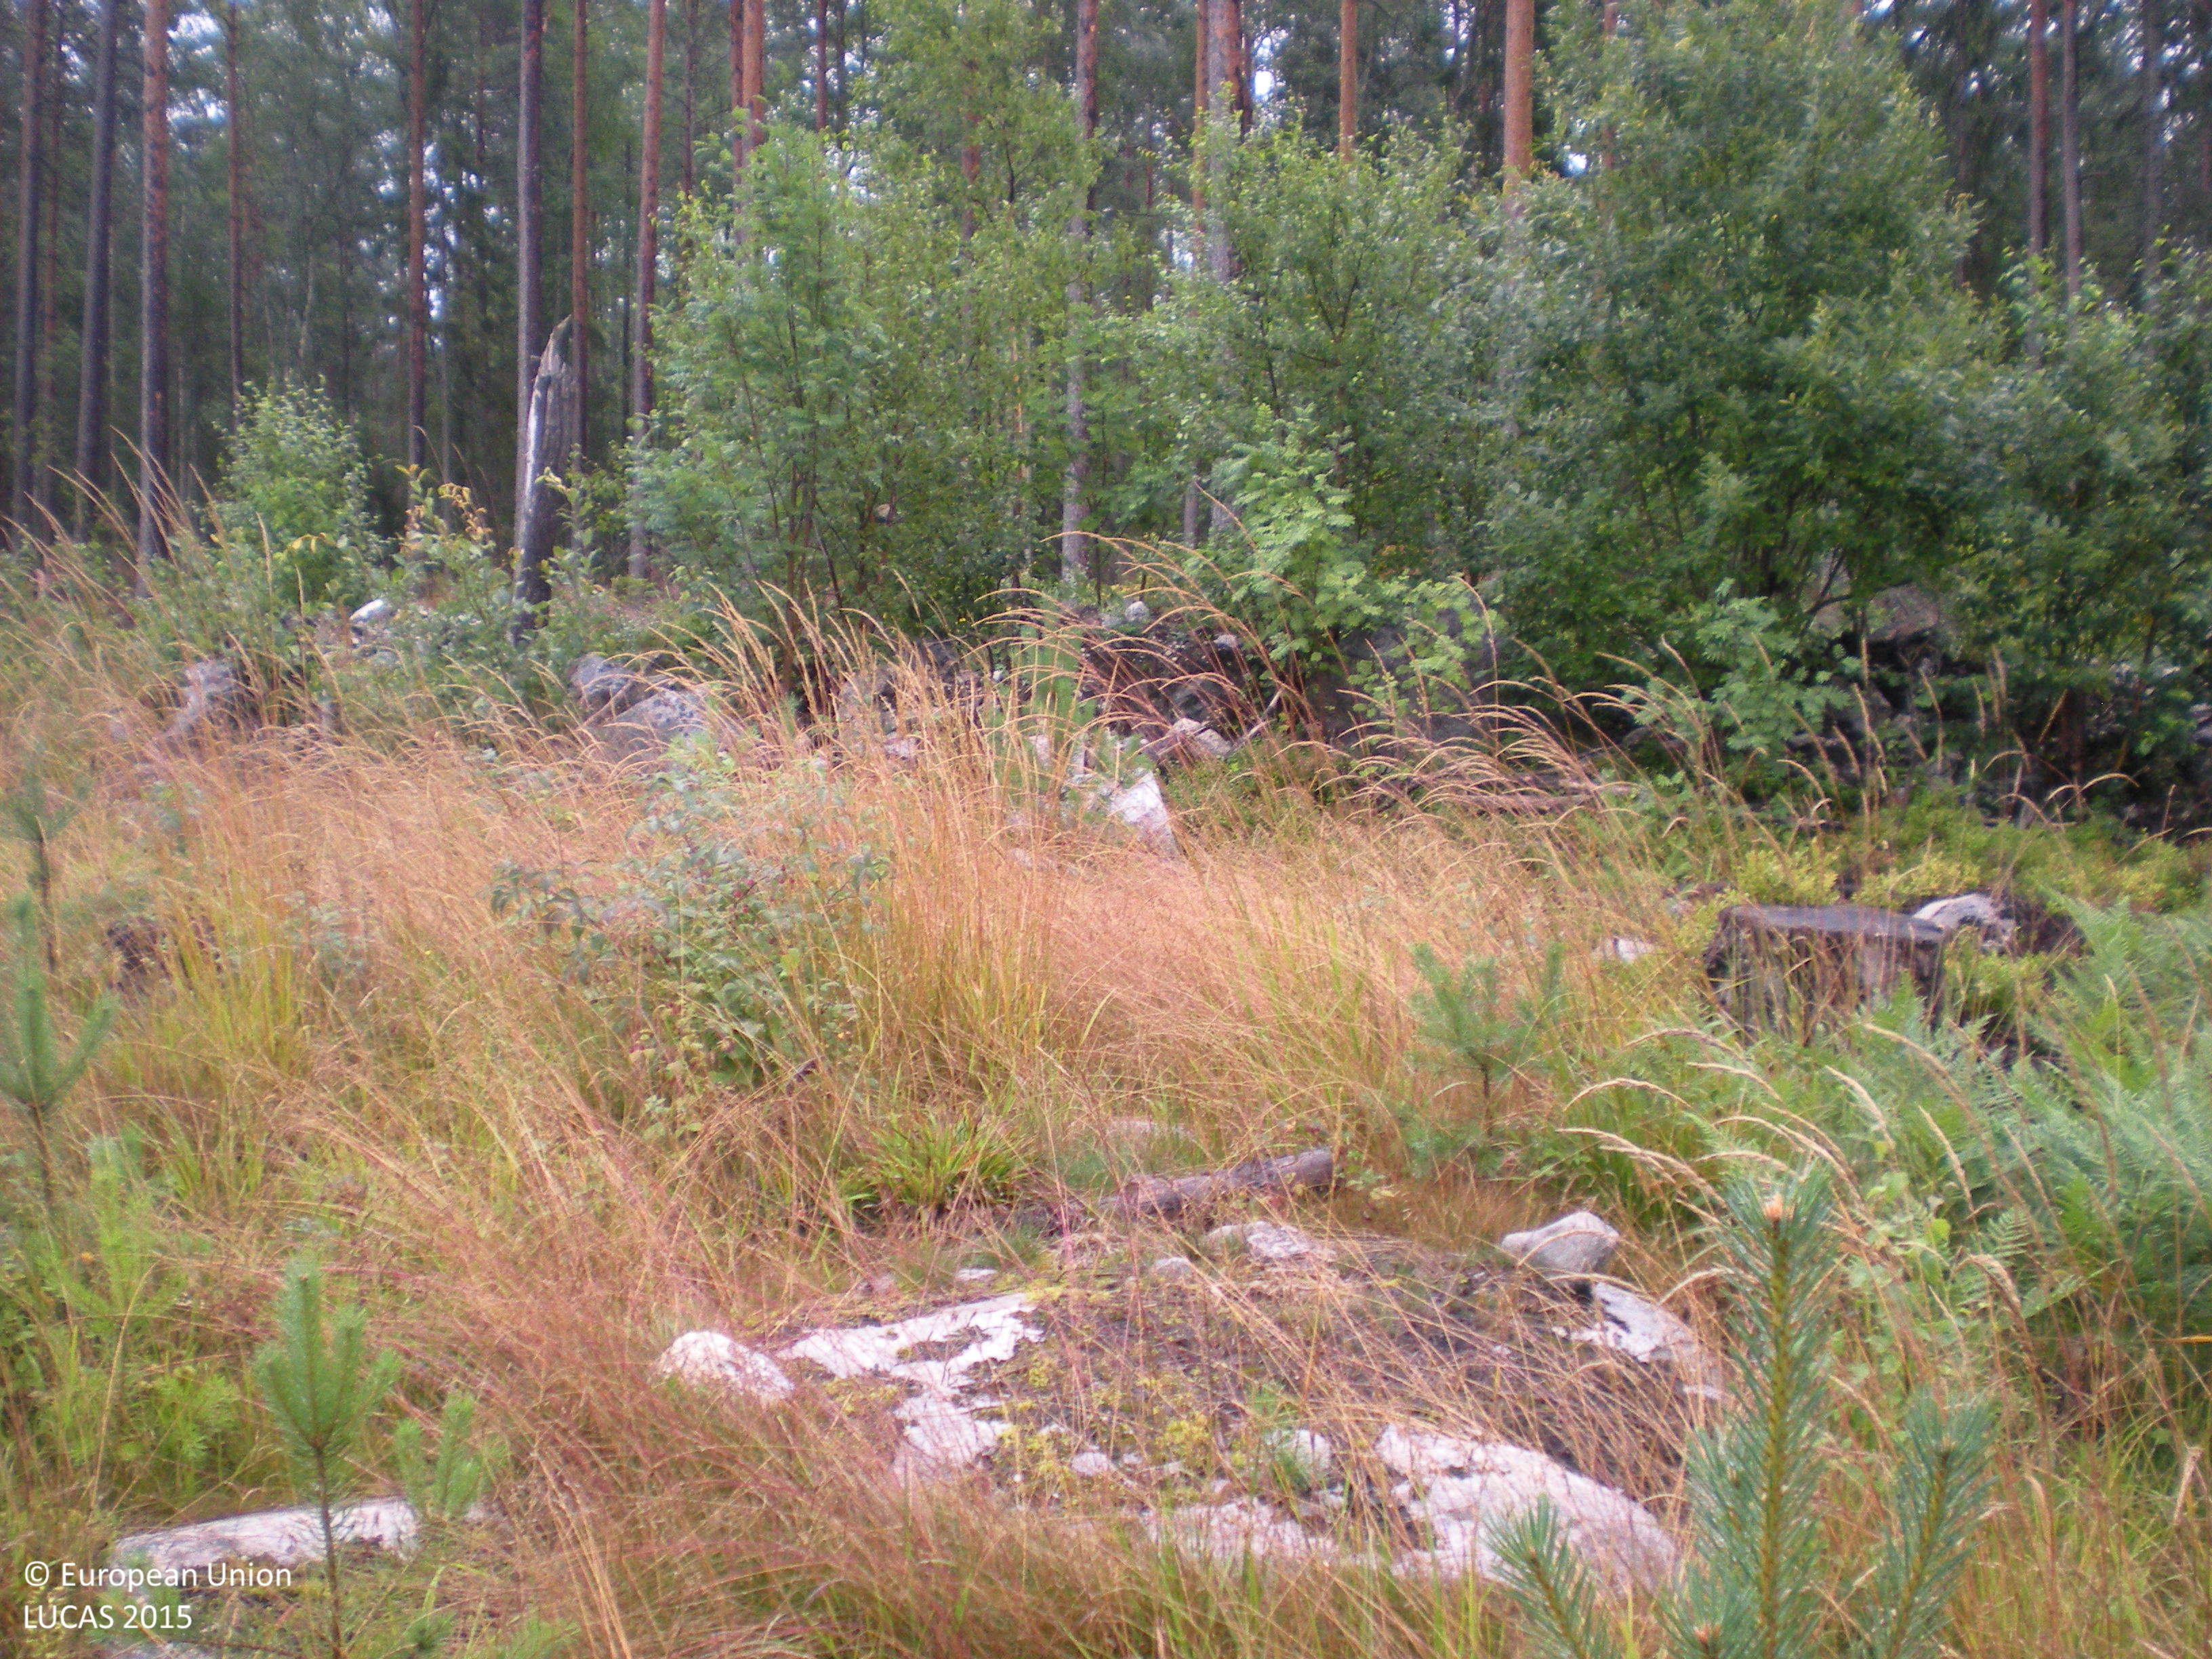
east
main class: Woodland
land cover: Pine dominated mixed woodland
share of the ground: 25 - 50 %
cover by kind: herbaceous plants 35 %, coniferous forest trees 20 %, shrubs 20 %, broadleaved forest trees 15 %, consolidated bare surface 5 %
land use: Forestry
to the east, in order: Pine dominated mixed woodland; Broadleaved woodland; Ditches and canals; Paved roads, cycling and walking lanes; Ditches and canals; Pine dominated coniferous woodland; Pine dominated mixed woodland; Pine dominated coniferous woodland; Tracks; Pine dominated coniferous woodland; Tracks; Other mixed woodland; Other coniferous woodland; Pine dominated coniferous woodland
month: August
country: SE
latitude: 60.7509
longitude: 17.3097
